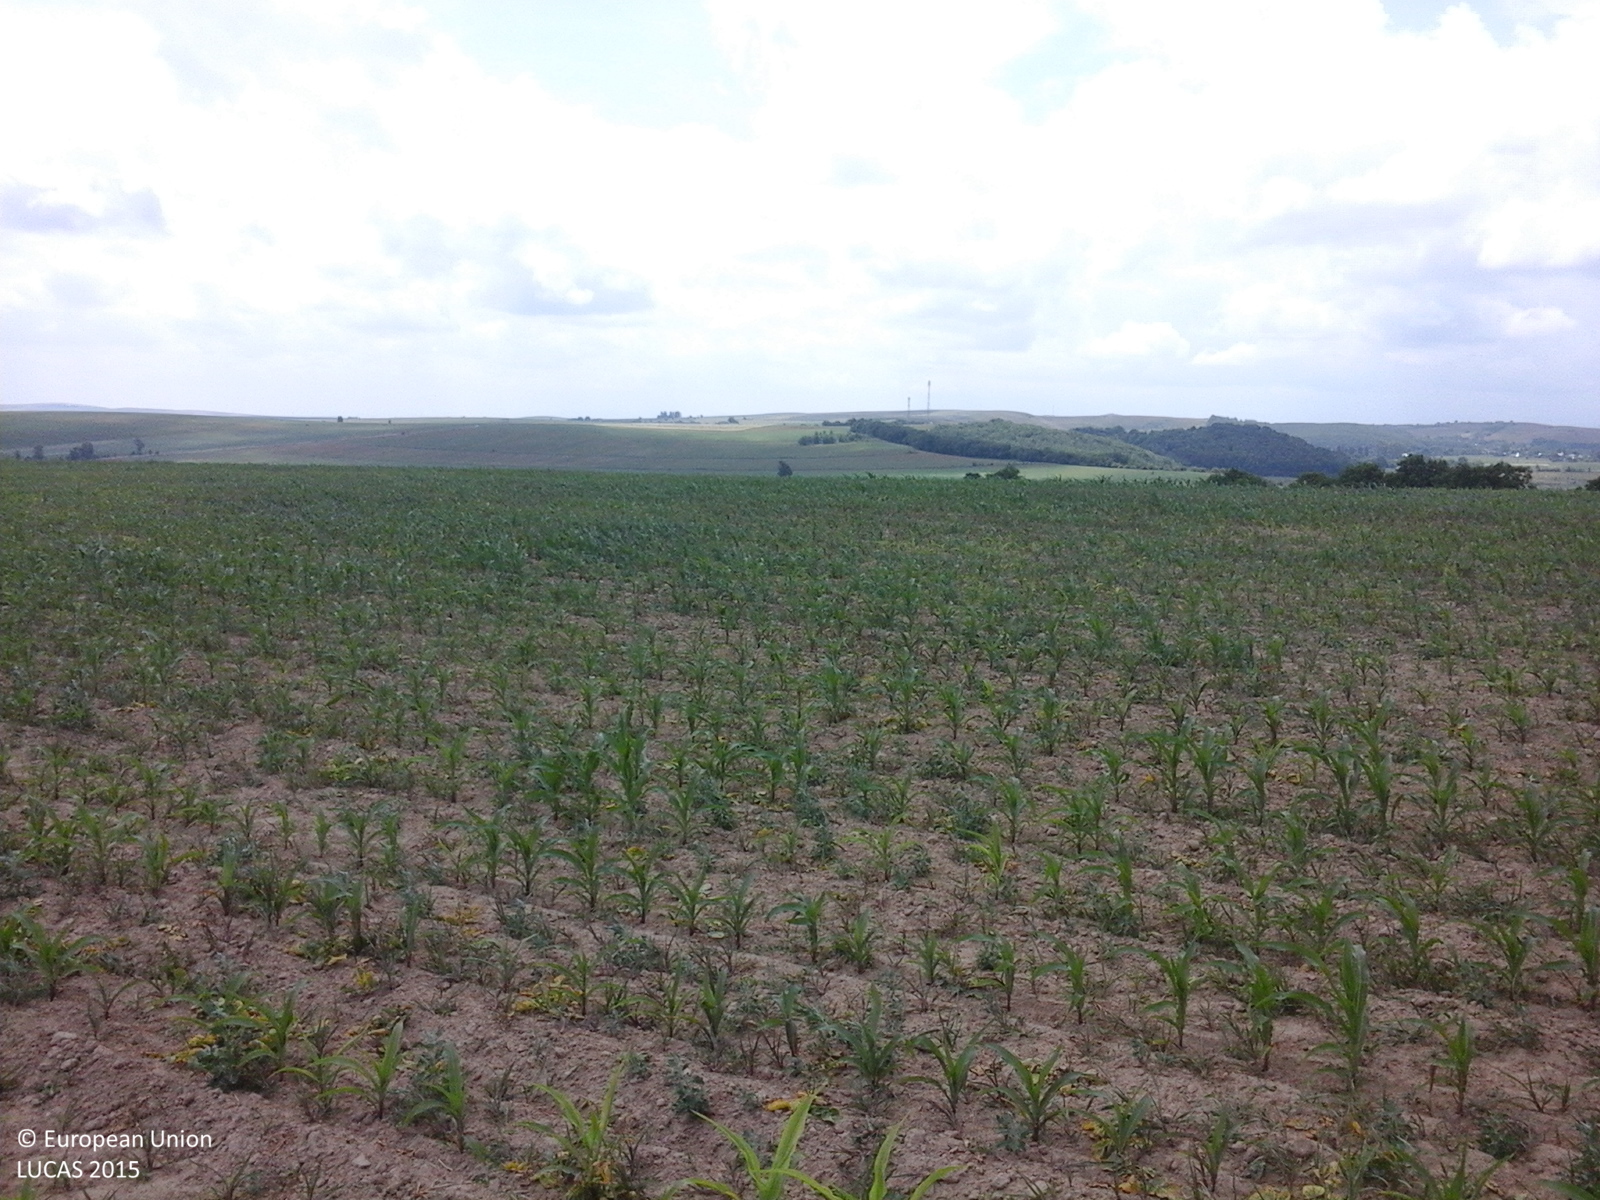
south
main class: Cropland
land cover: Maize
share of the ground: 10 - 25 %
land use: Agriculture (excluding fallow land and kitchen gardens)
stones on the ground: < 10 %
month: June
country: RO
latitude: 47.0480
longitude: 26.5812
